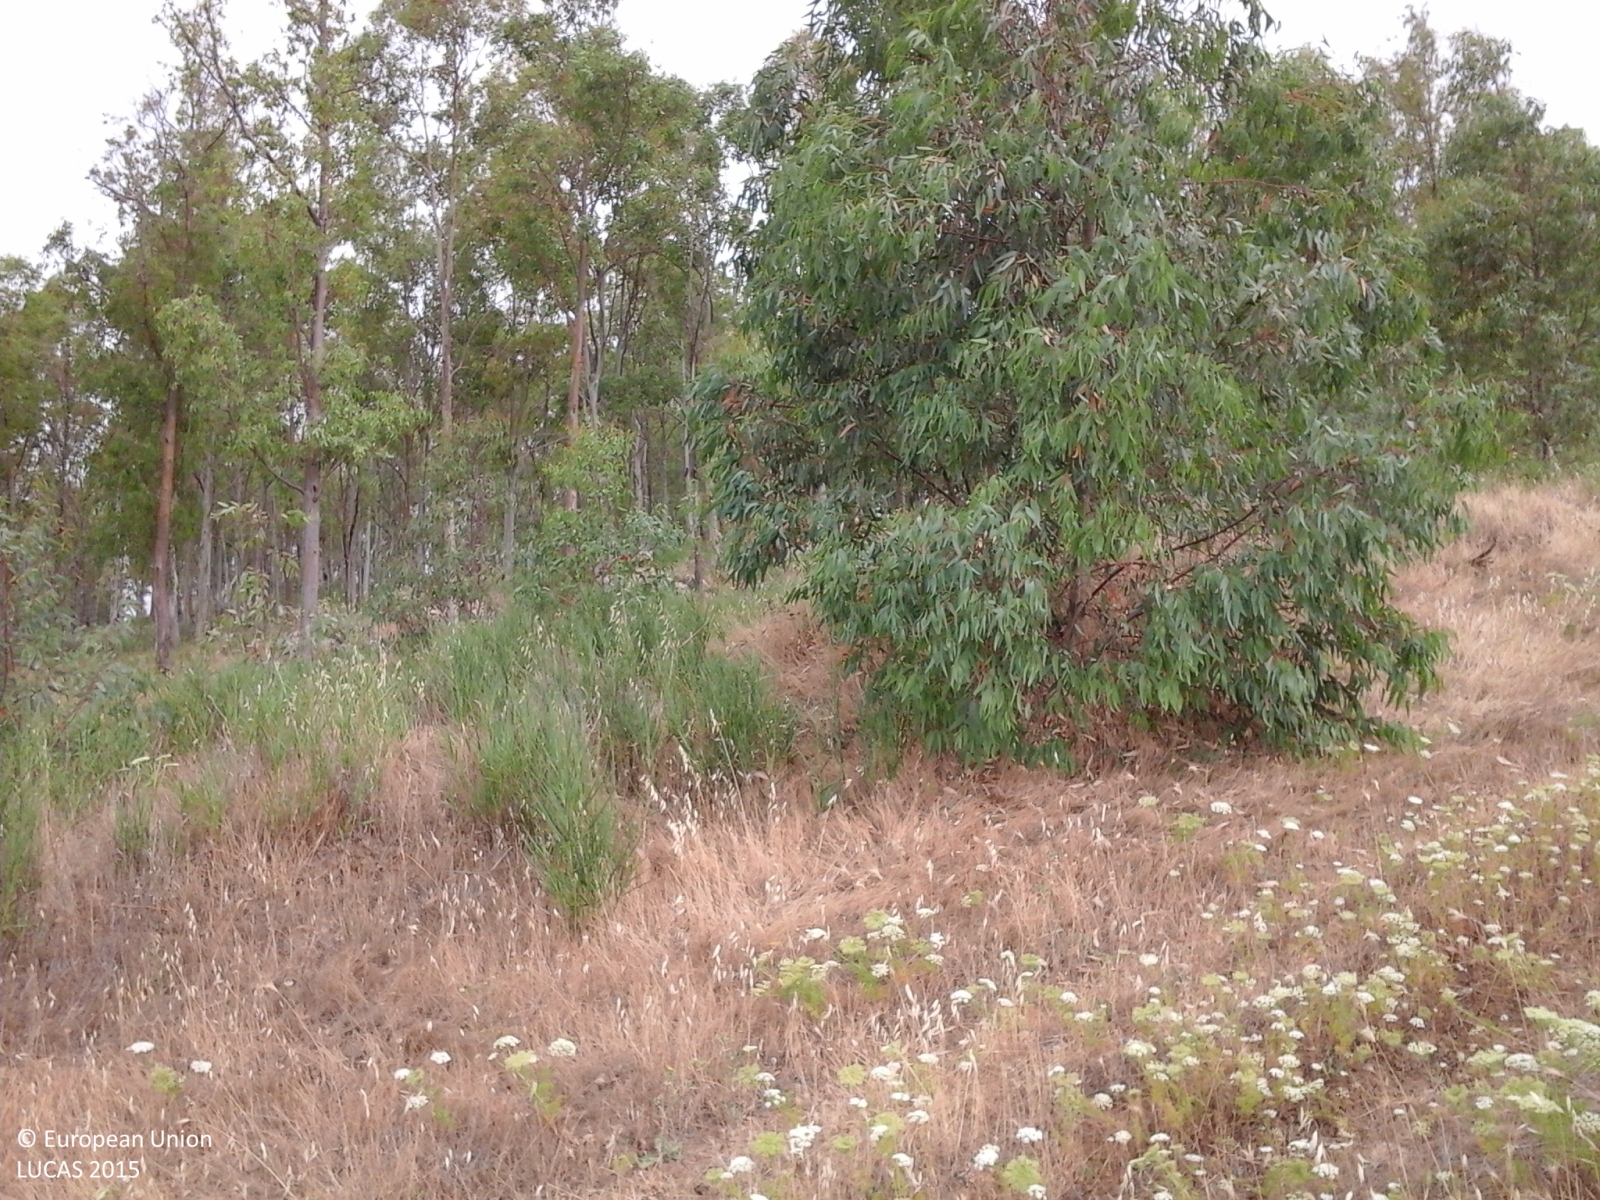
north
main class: Cropland
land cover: Other leguminous and mixtures for fodder
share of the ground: > 75 %
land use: Agriculture (excluding fallow land and kitchen gardens)
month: June
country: IT
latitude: 37.4422
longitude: 14.0722
